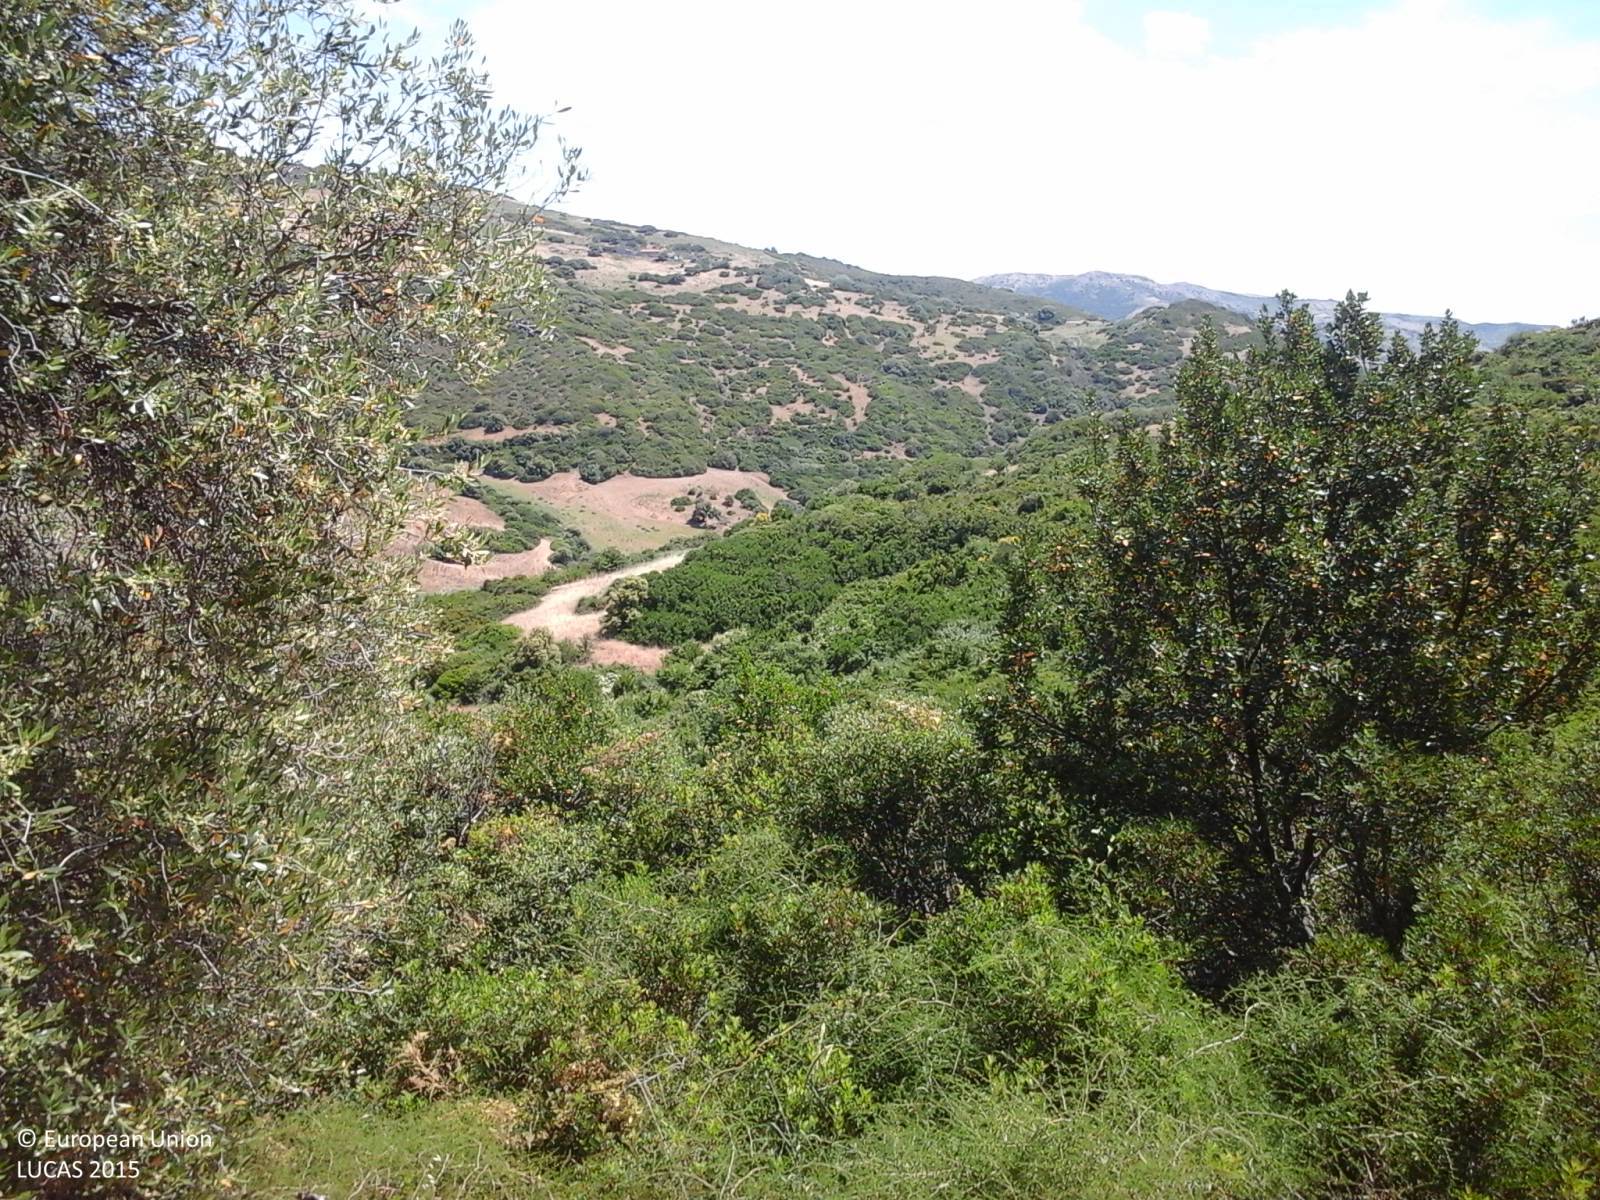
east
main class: Shrubland
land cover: Shrubland with sparse tree cover
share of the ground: > 75 %
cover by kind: shrubs 50 %, herbaceous plants 40 %, broadleaved forest trees 5 %
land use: Semi-natural and natural areas not in use
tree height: < 5 m
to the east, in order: Shrubland with sparse tree cover; Grassland without tree/shrub cover; Shrubland with sparse tree cover
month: May
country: IT
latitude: 40.8013
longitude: 8.6670
